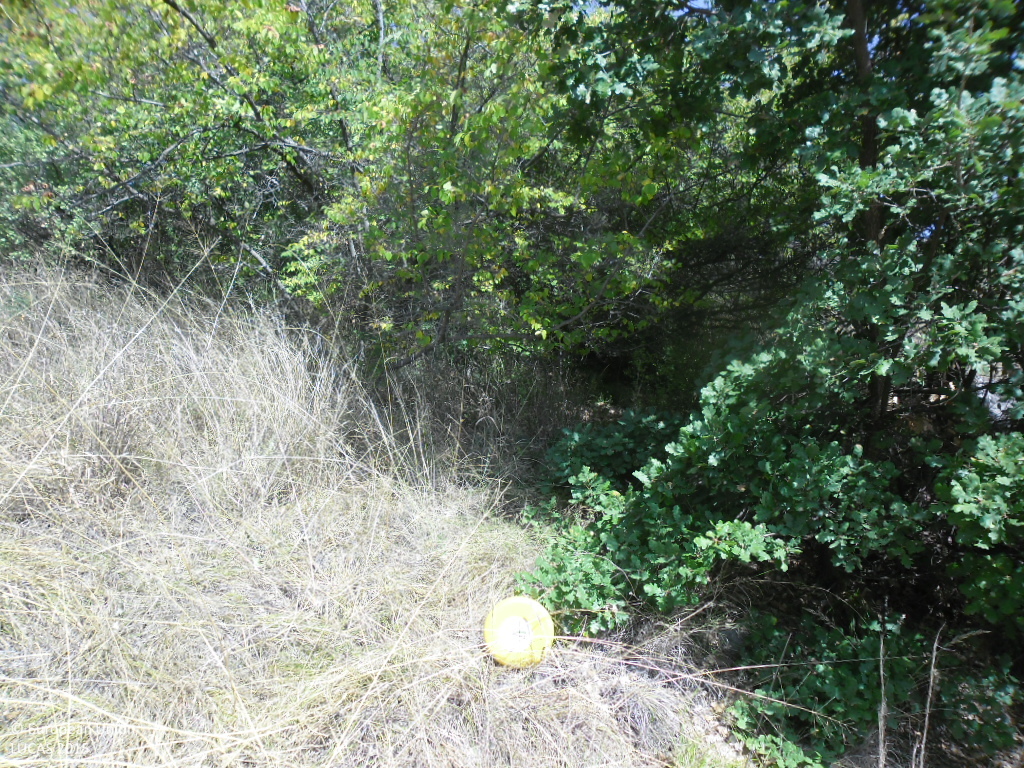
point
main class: Woodland
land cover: Broadleaved woodland
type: thermophilous deciduous forest
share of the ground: > 75 %
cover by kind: broadleaved forest trees 85 %, unconsolidated bare surface 10 %, coniferous forest trees 5 %
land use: Forestry
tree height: < 5 m
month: September
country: BG
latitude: 41.6732
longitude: 23.2230
